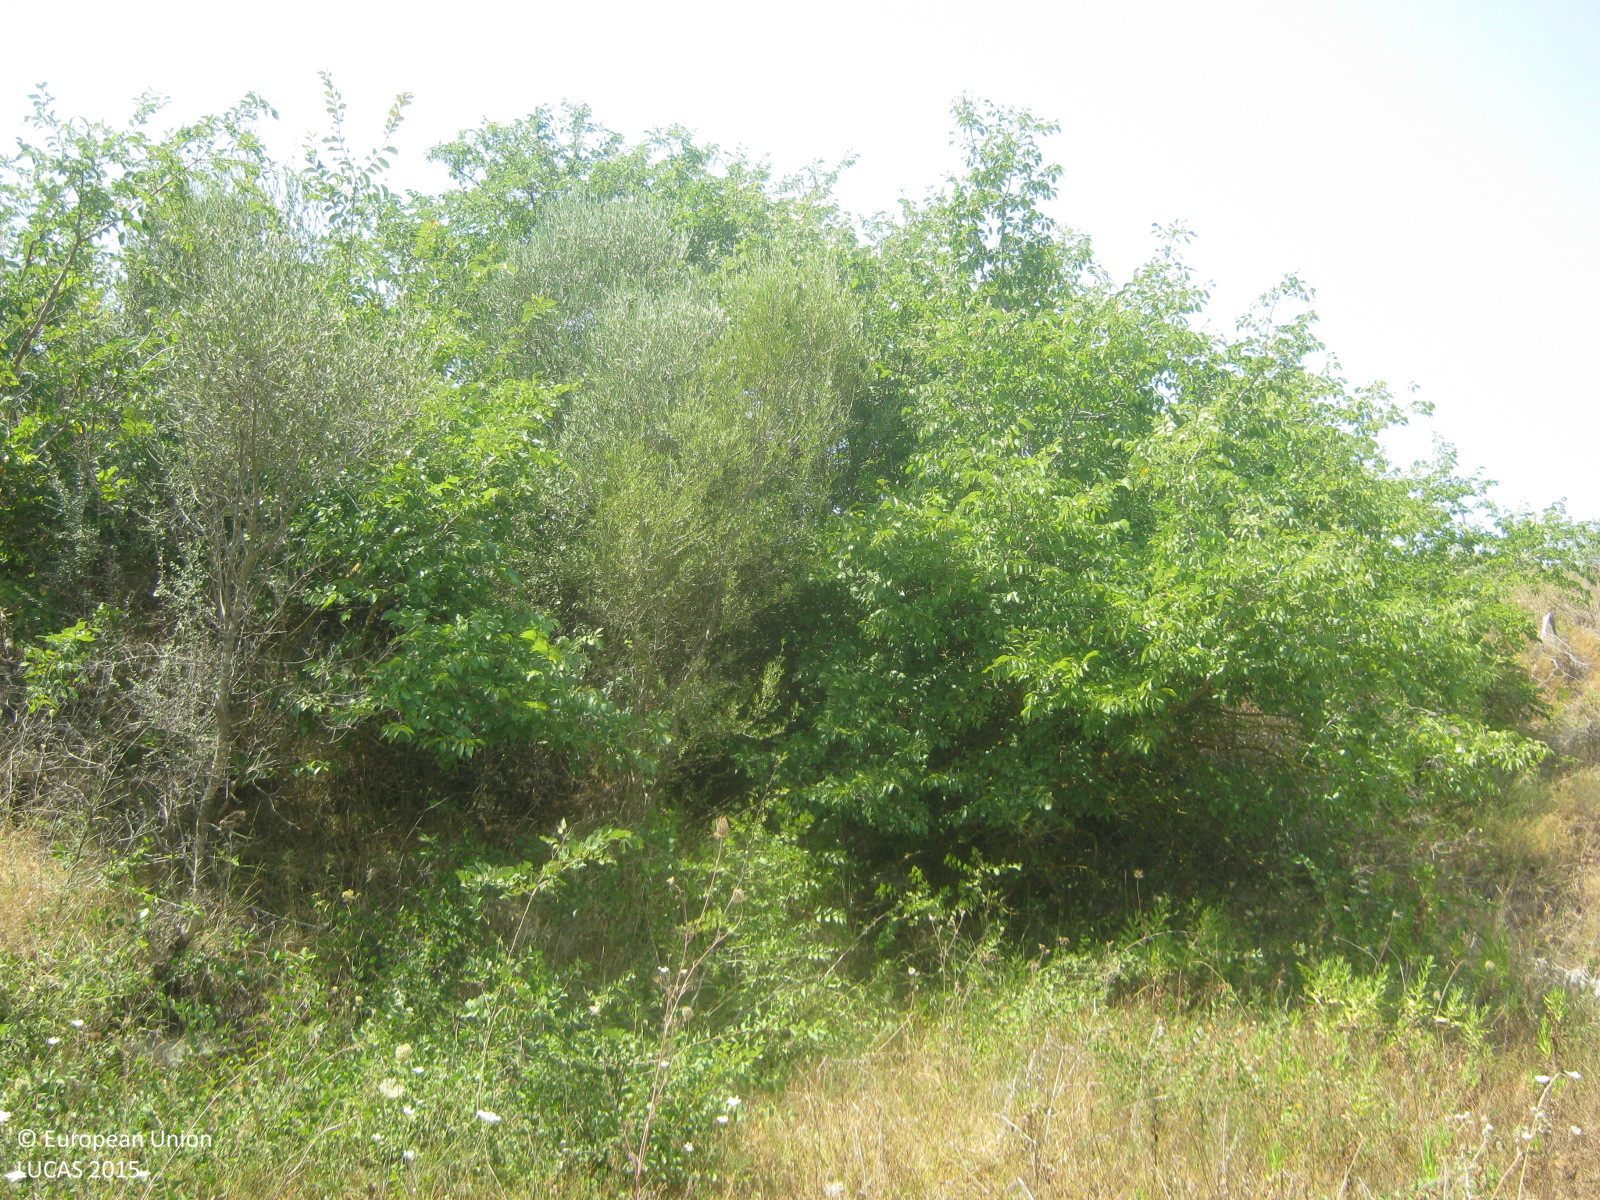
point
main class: Woodland
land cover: Broadleaved woodland
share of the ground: 50 - 75 %
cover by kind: broadleaved forest trees 50 %, herbaceous plants 30 %, consolidated bare surface 15 %, shrubs 5 %
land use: Agriculture (excluding fallow land and kitchen gardens)
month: August
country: GR
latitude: 38.2337
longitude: 20.4144
